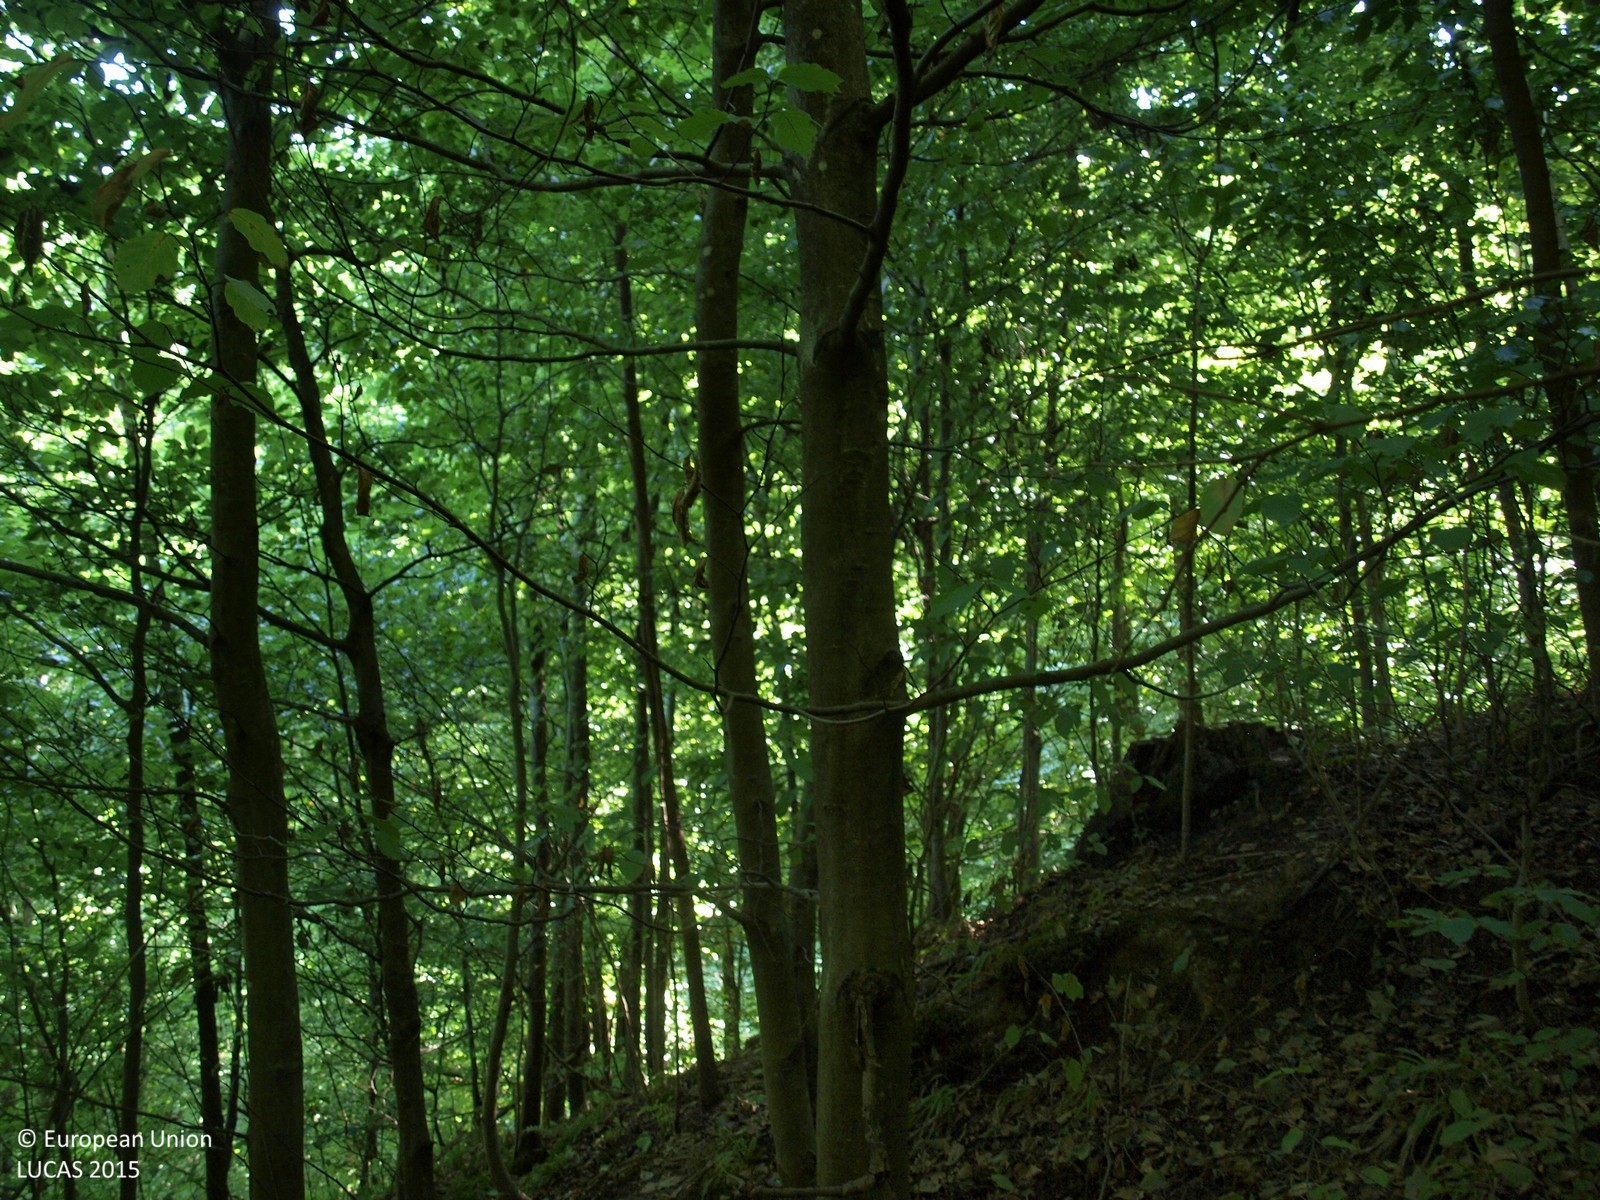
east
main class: Woodland
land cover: Broadleaved woodland
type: beech forest
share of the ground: > 75 %
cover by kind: broadleaved forest trees 100 %
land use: Forestry
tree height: > 5 m
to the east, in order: Broadleaved woodland; Paved roads, cycling and walking lanes; Electric lines; Vineyards; Grassland without tree/shrub cover
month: August
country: HR
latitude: 46.0005
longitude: 16.3393
